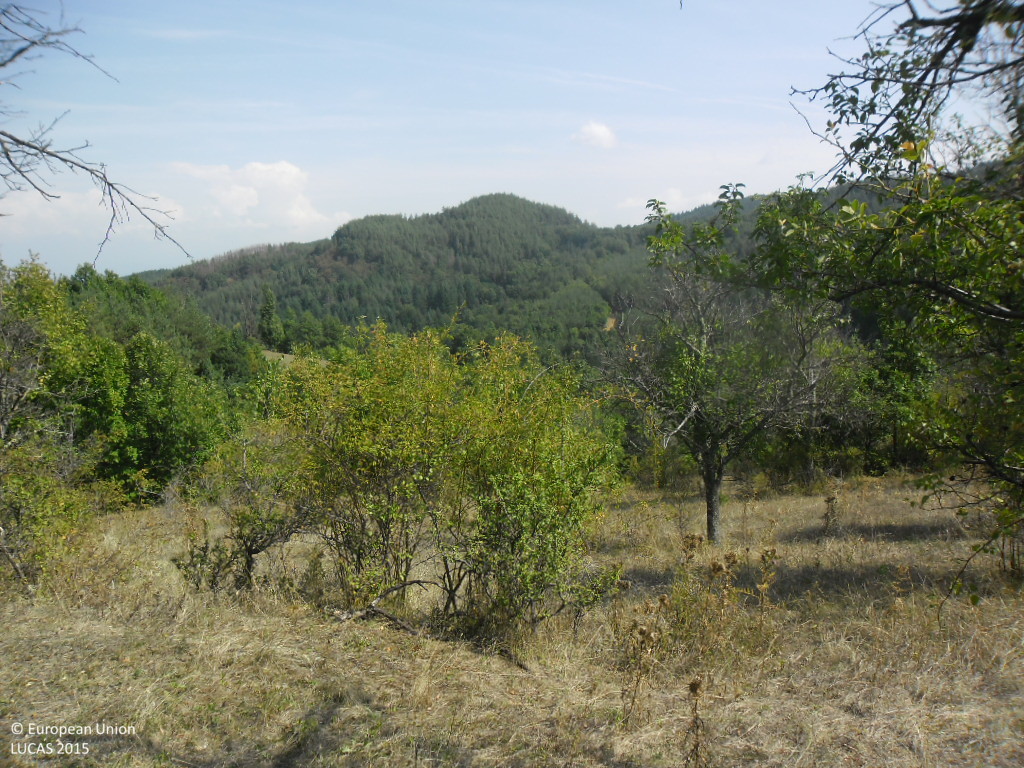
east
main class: Cropland
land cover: Other fruit trees and berries
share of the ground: 25 - 50 %
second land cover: Grassland without tree/shrub cover
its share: > 75 %
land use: Agriculture (excluding fallow land and kitchen gardens)
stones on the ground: < 10 %
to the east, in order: Other fruit trees and berries; Grassland without tree/shrub cover; Grassland with sparse tree/shrub cover; Broadleaved woodland; Grassland with sparse tree/shrub cover; Grassland without tree/shrub cover; Tracks; Grassland without tree/shrub cover; Grassland with sparse tree/shrub cover
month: September
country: BG
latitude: 41.8884
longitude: 22.9770
